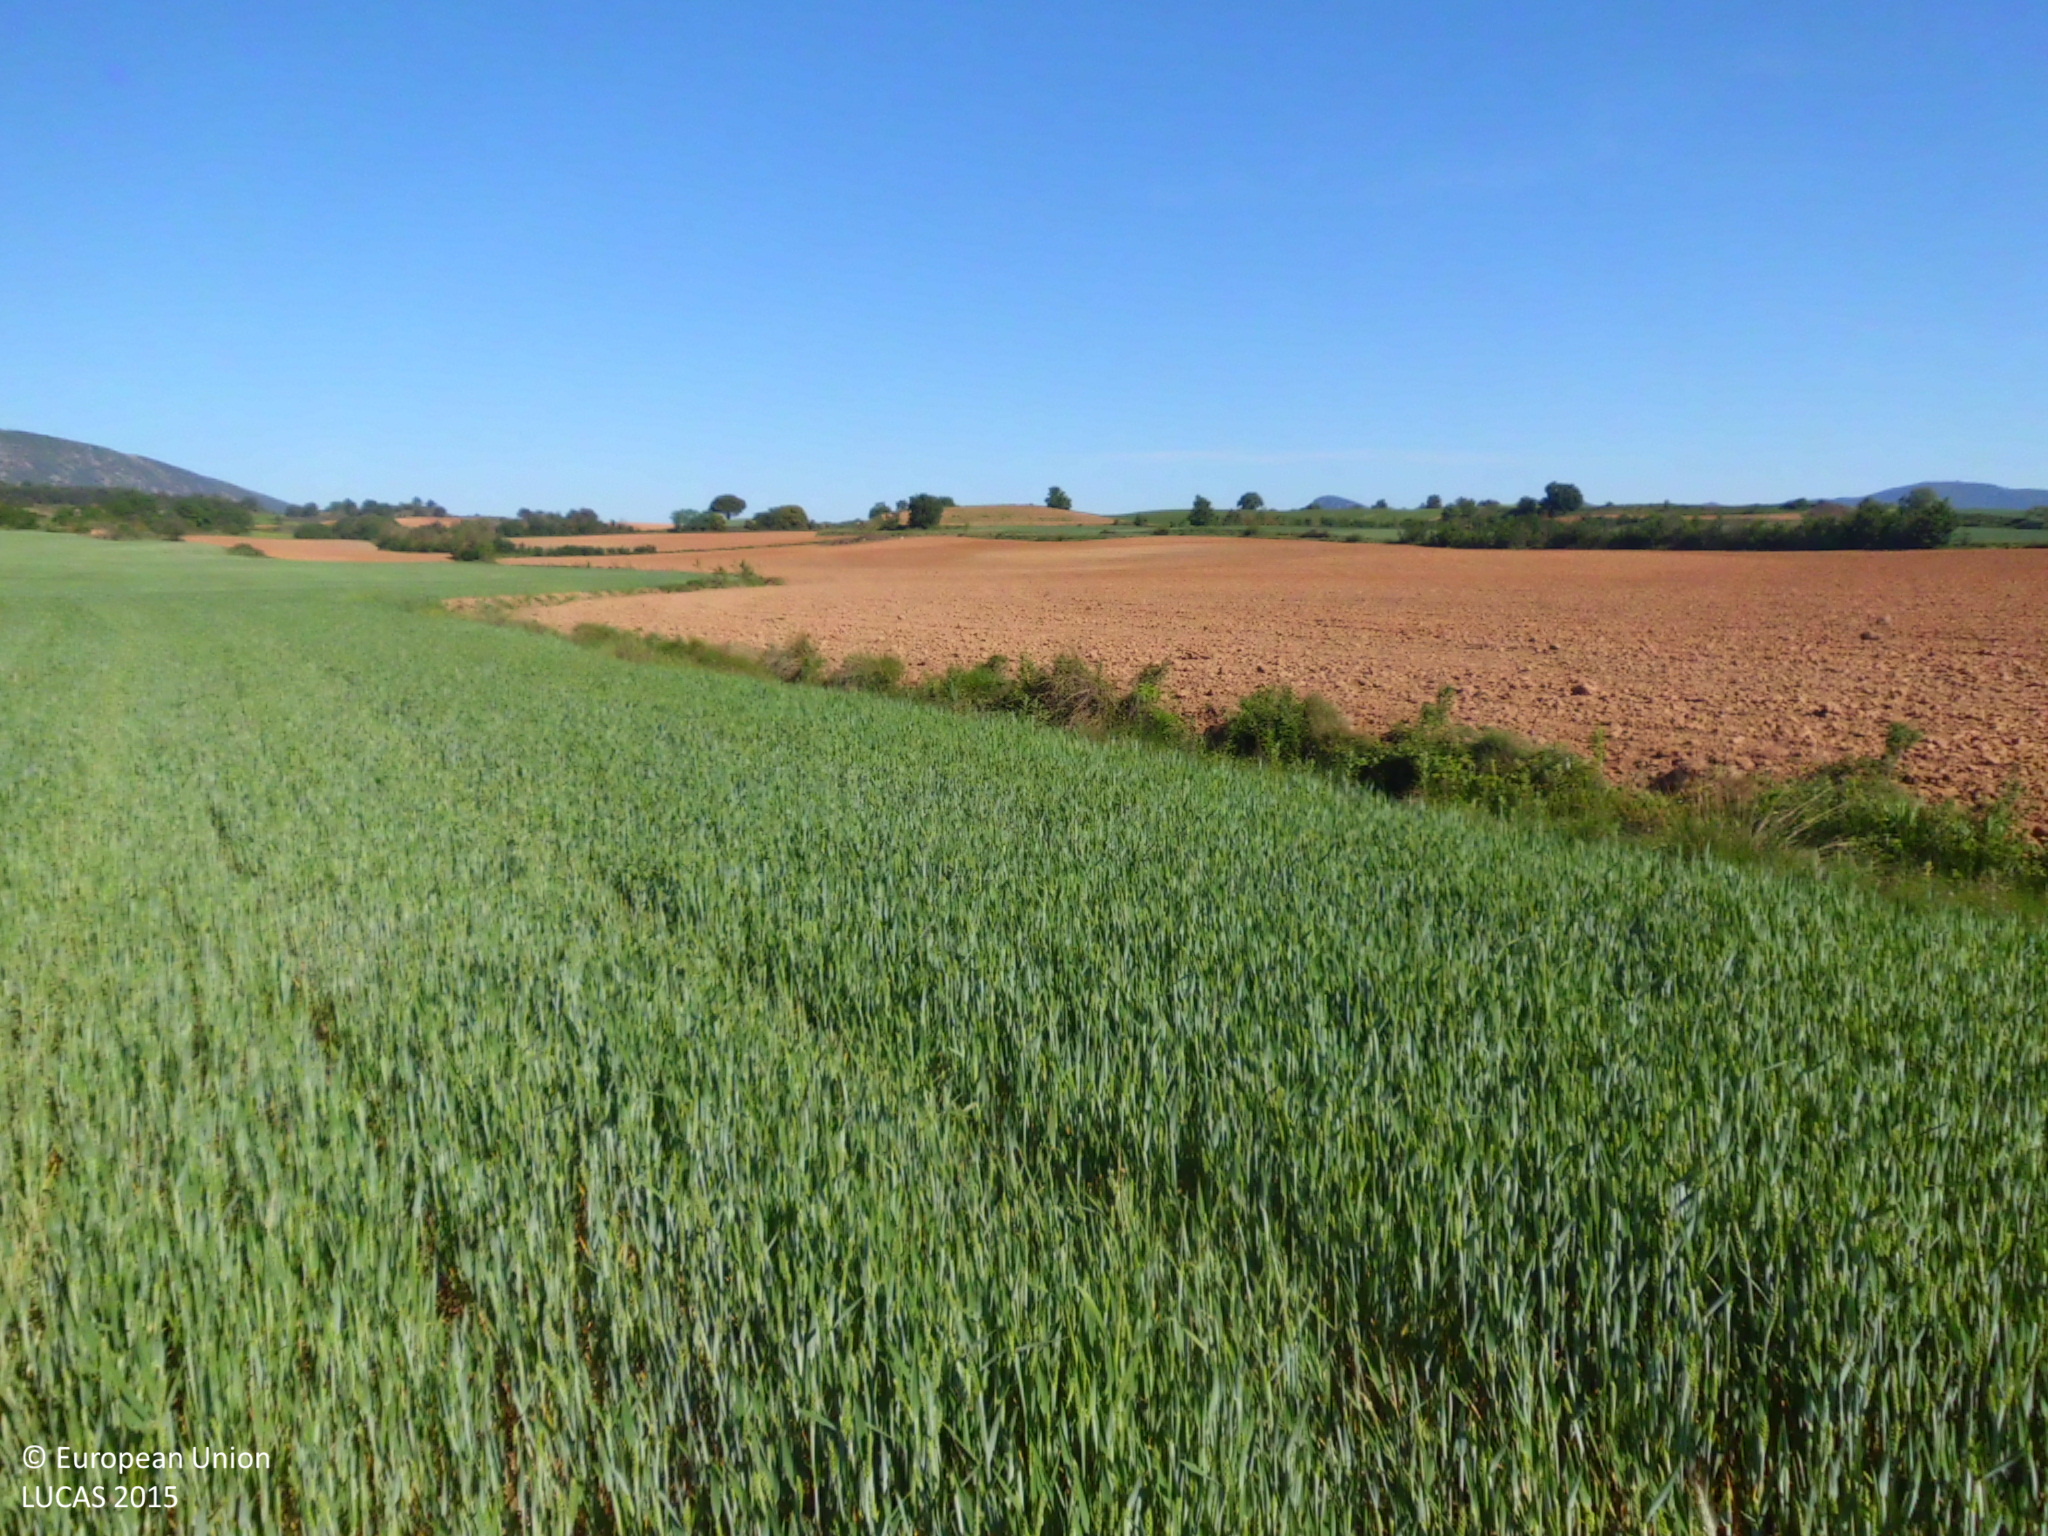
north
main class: Cropland
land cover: Common wheat
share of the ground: > 75 %
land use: Agriculture (excluding fallow land and kitchen gardens)
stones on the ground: 25 - 50 %
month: May
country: ES
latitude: 42.6671
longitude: -3.4447
